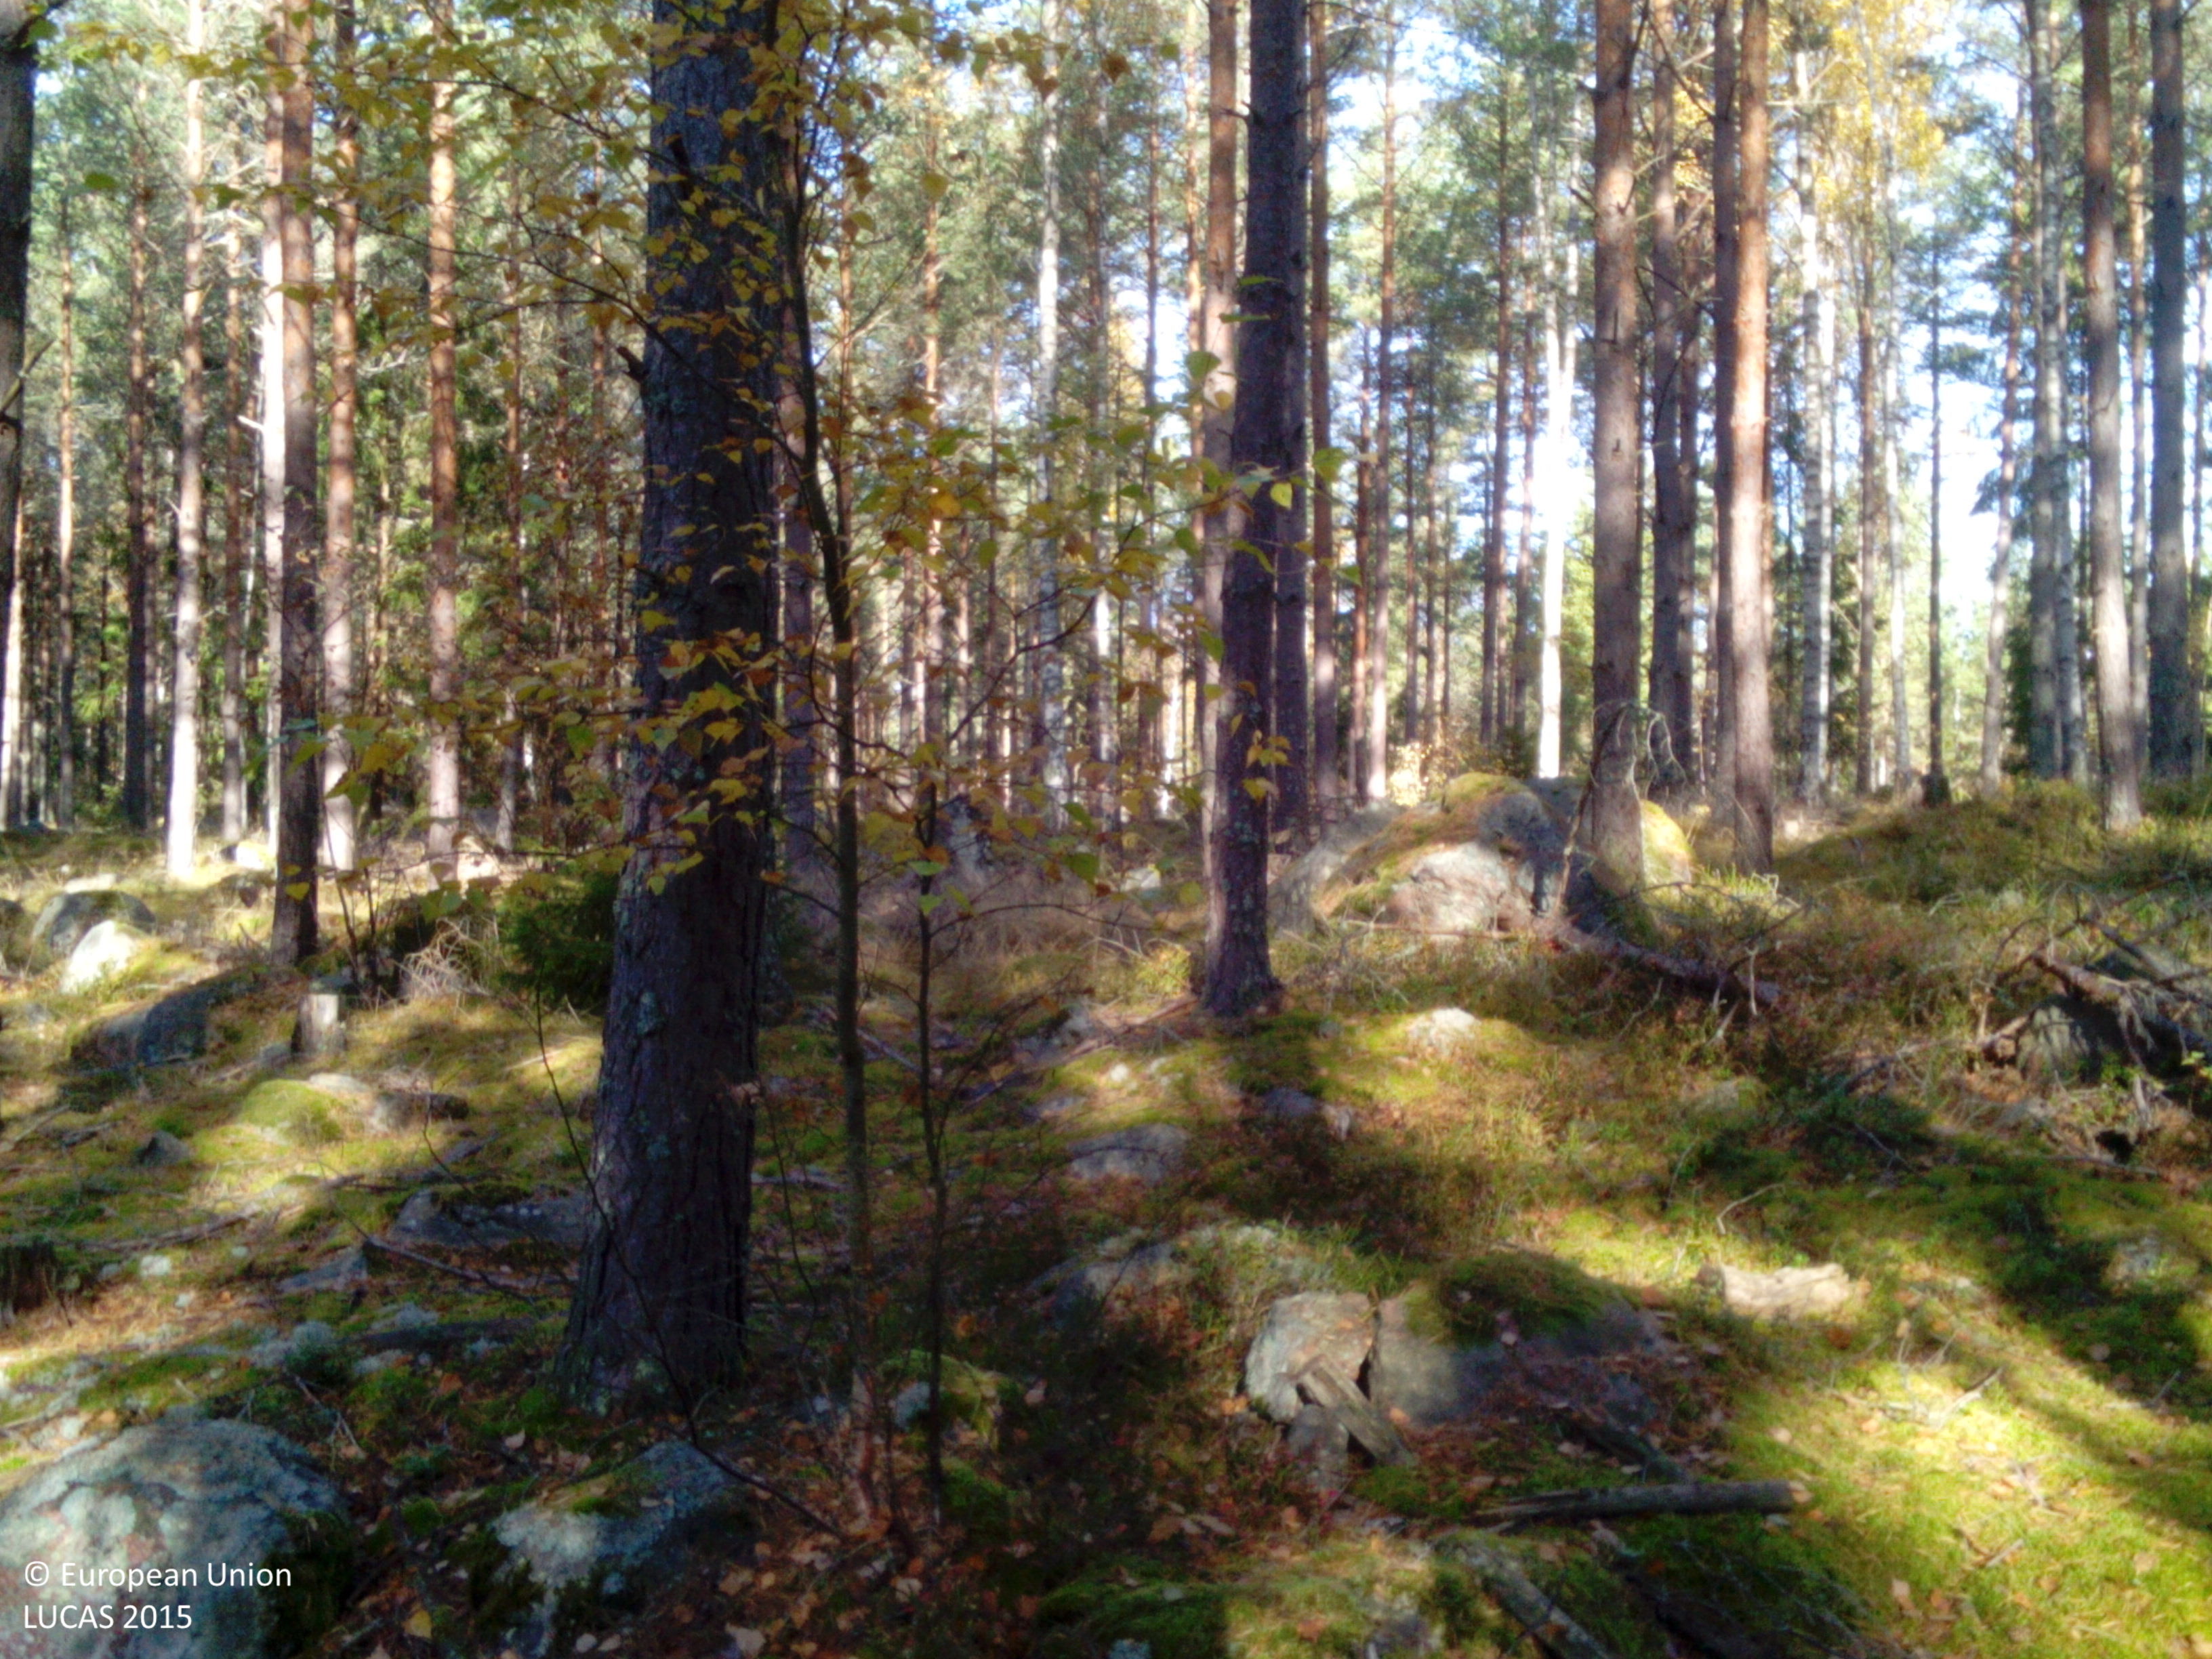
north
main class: Woodland
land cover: Pine dominated coniferous woodland
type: boreal forest
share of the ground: > 75 %
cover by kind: coniferous forest trees 75 %, broadleaved forest trees 10 %, lichens and mosses 10 %, herbaceous plants 5 %
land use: Forestry
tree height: > 5 m
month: October
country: SE
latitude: 59.0261
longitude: 16.3525
